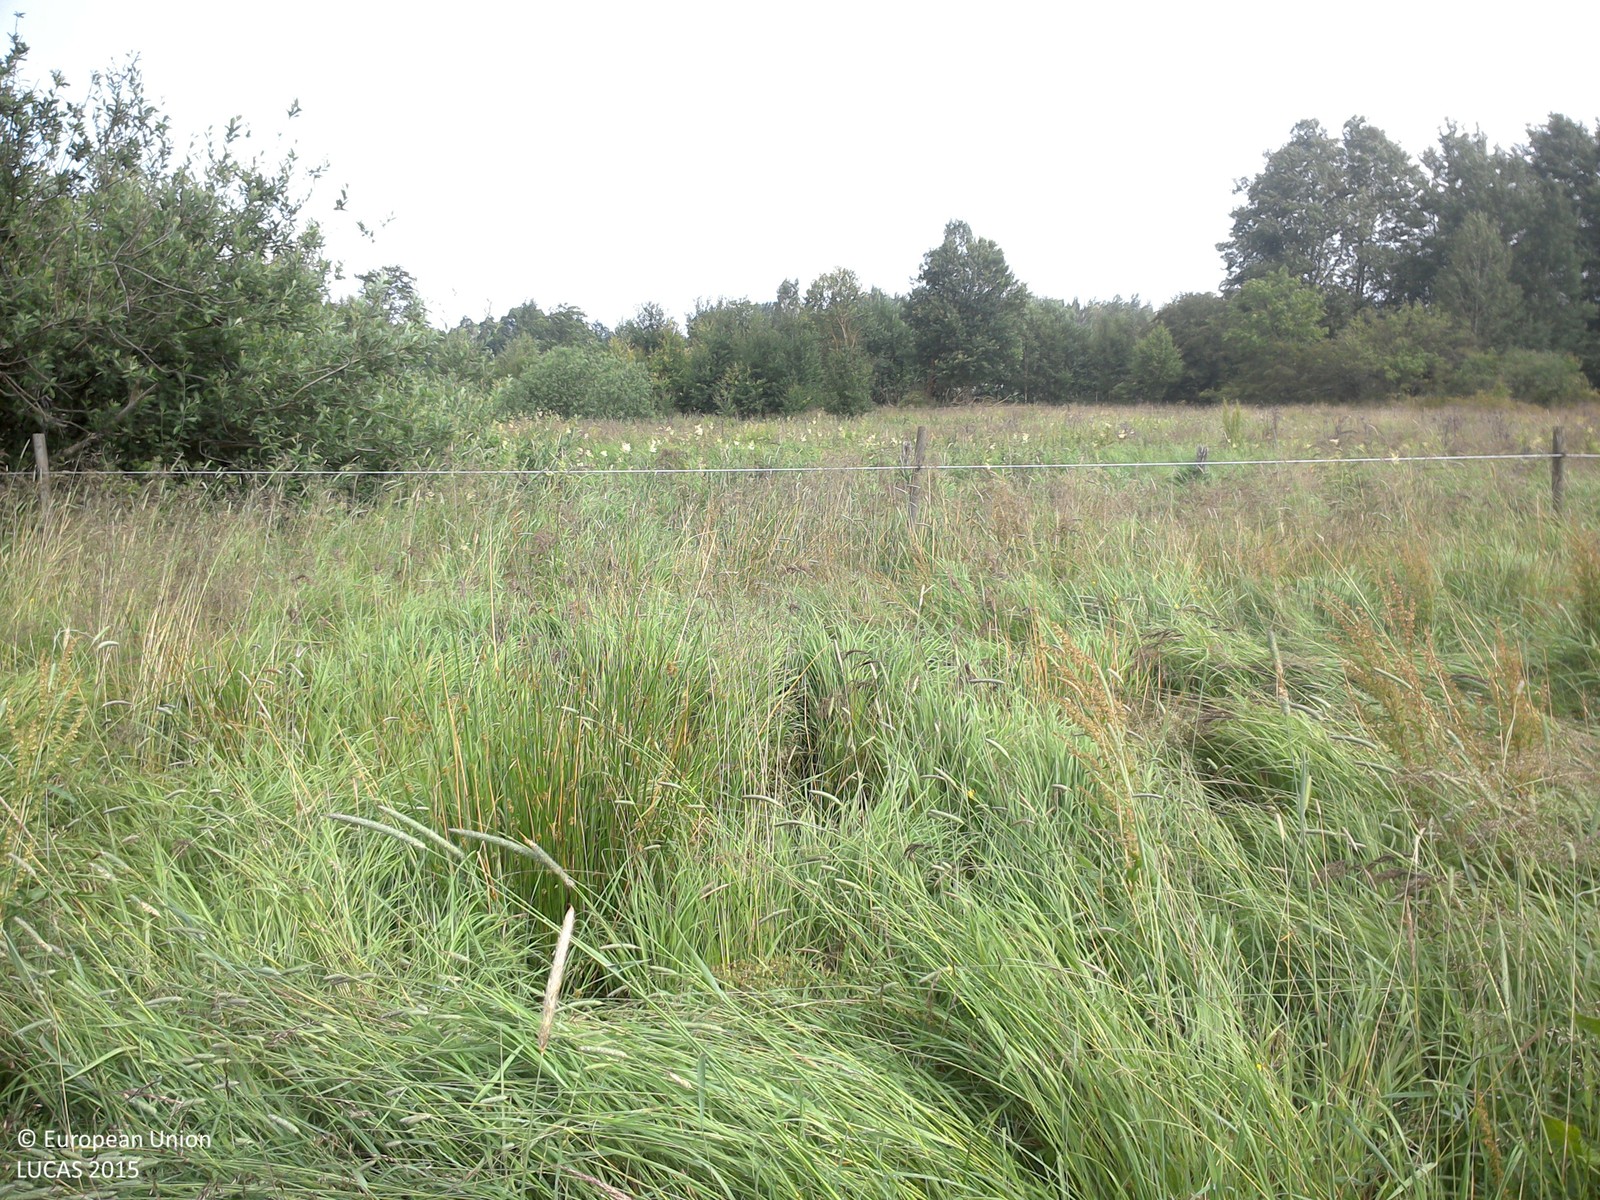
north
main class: Grassland
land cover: Grassland without tree/shrub cover
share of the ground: > 75 %
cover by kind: herbaceous plants 100 %
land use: Agriculture (excluding fallow land and kitchen gardens)
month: July
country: SE
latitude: 58.5990
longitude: 14.8976
